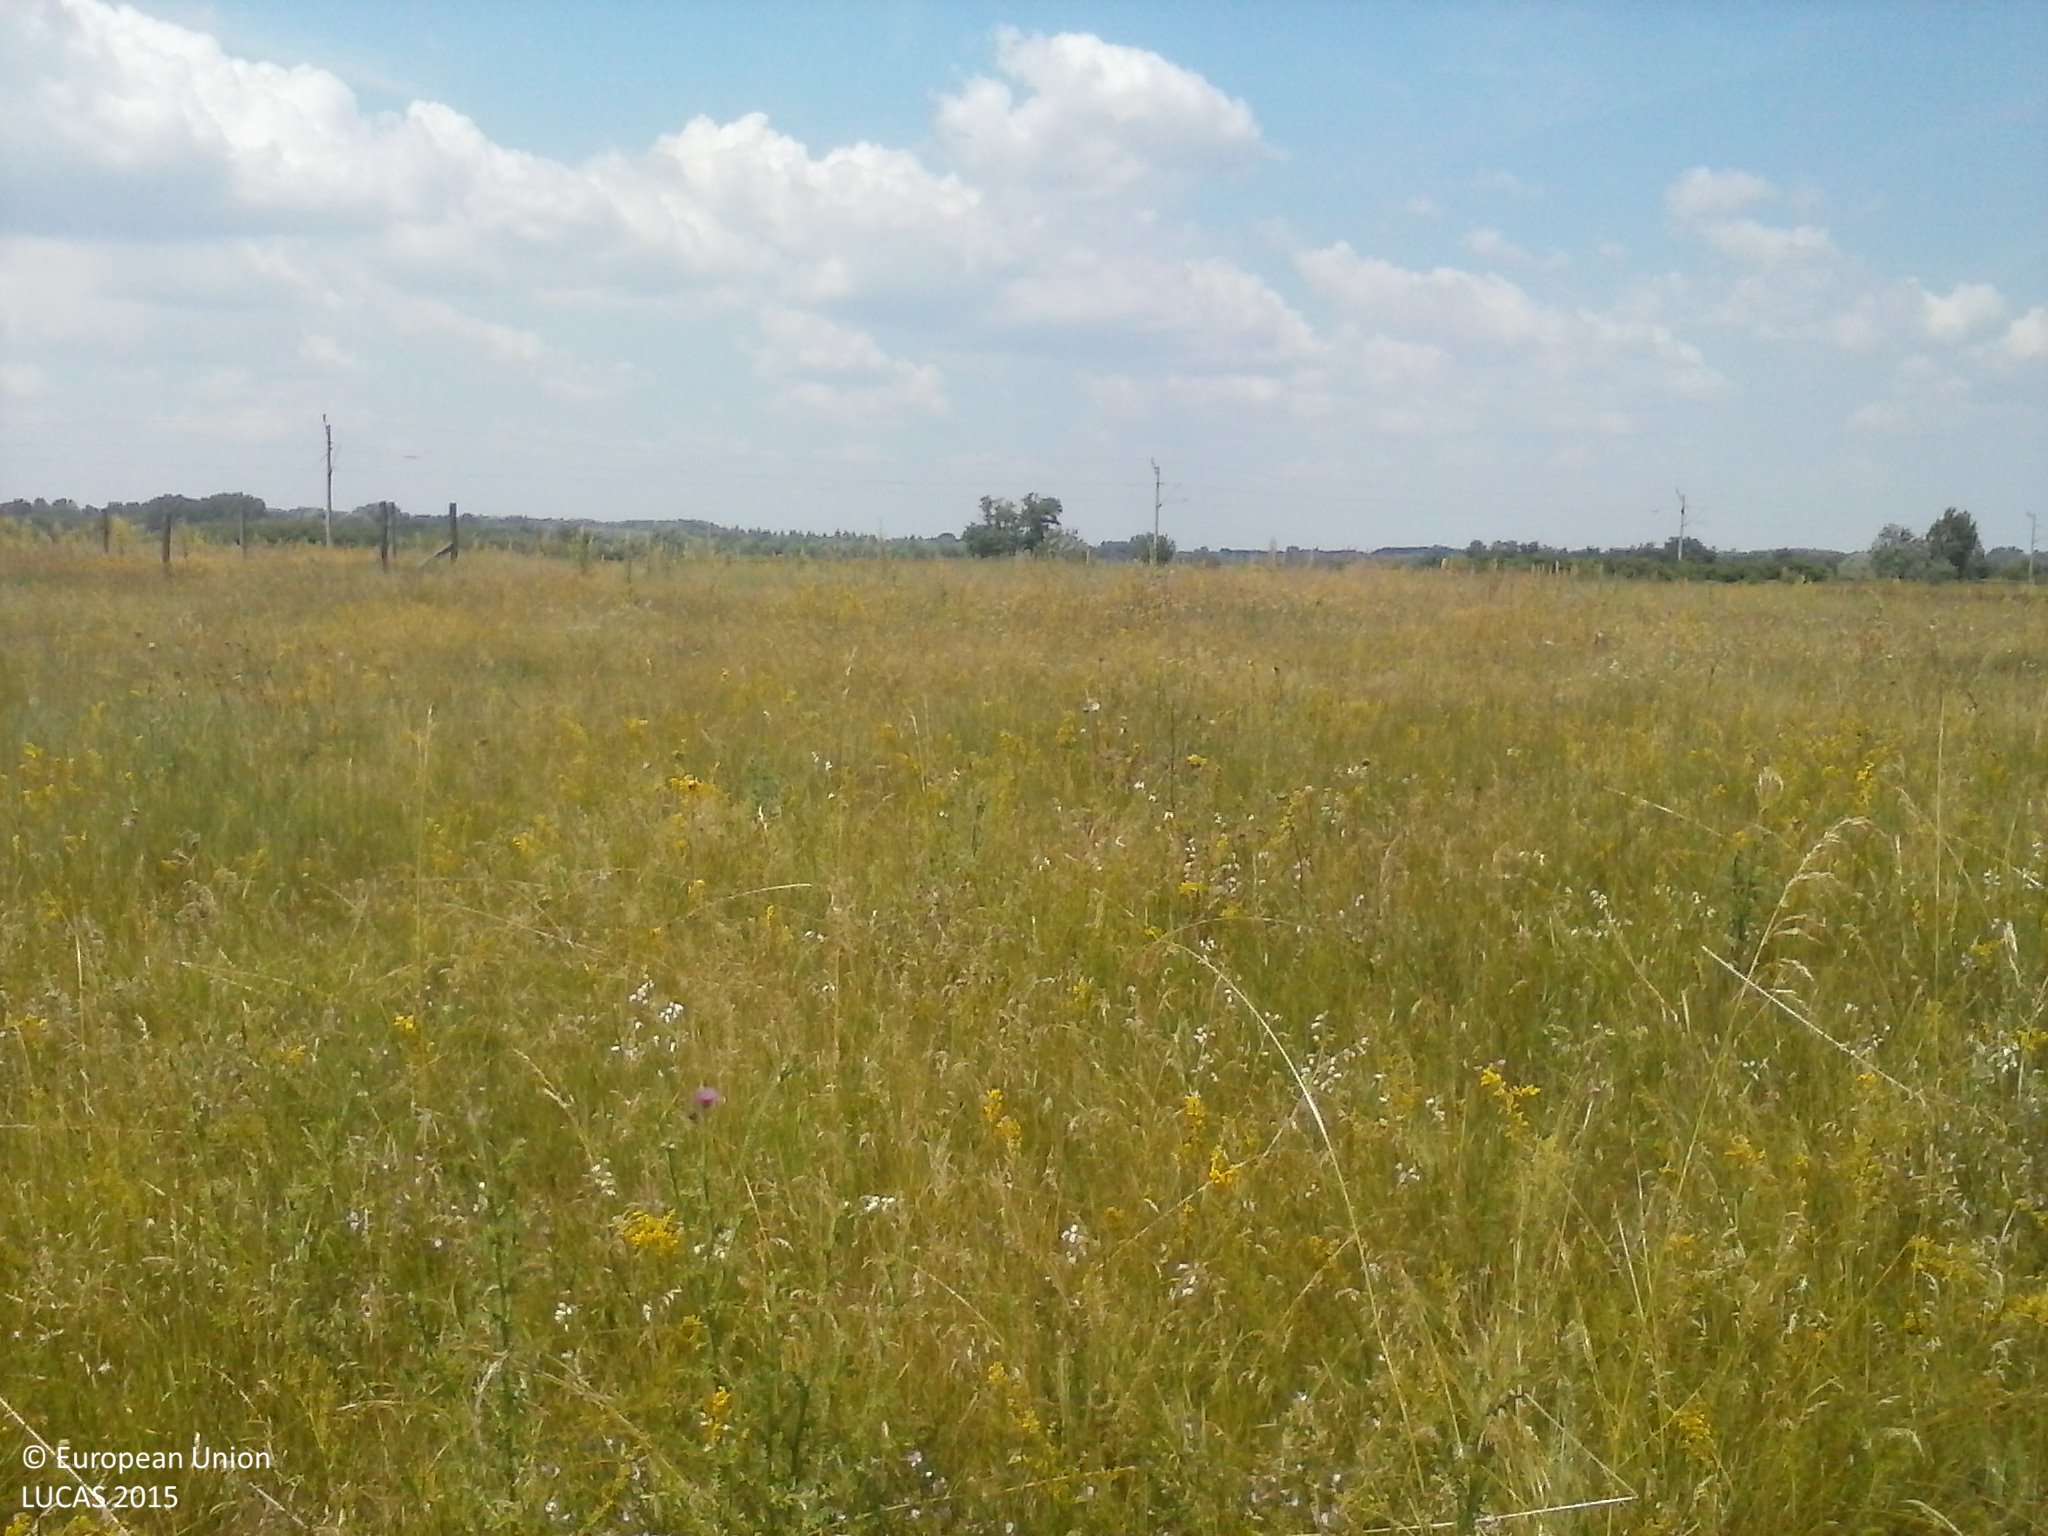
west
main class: Grassland
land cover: Grassland without tree/shrub cover
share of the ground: > 75 %
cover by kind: herbaceous plants 100 %
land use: Agriculture (excluding fallow land and kitchen gardens)
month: July
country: HU
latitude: 46.3230
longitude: 19.5373
